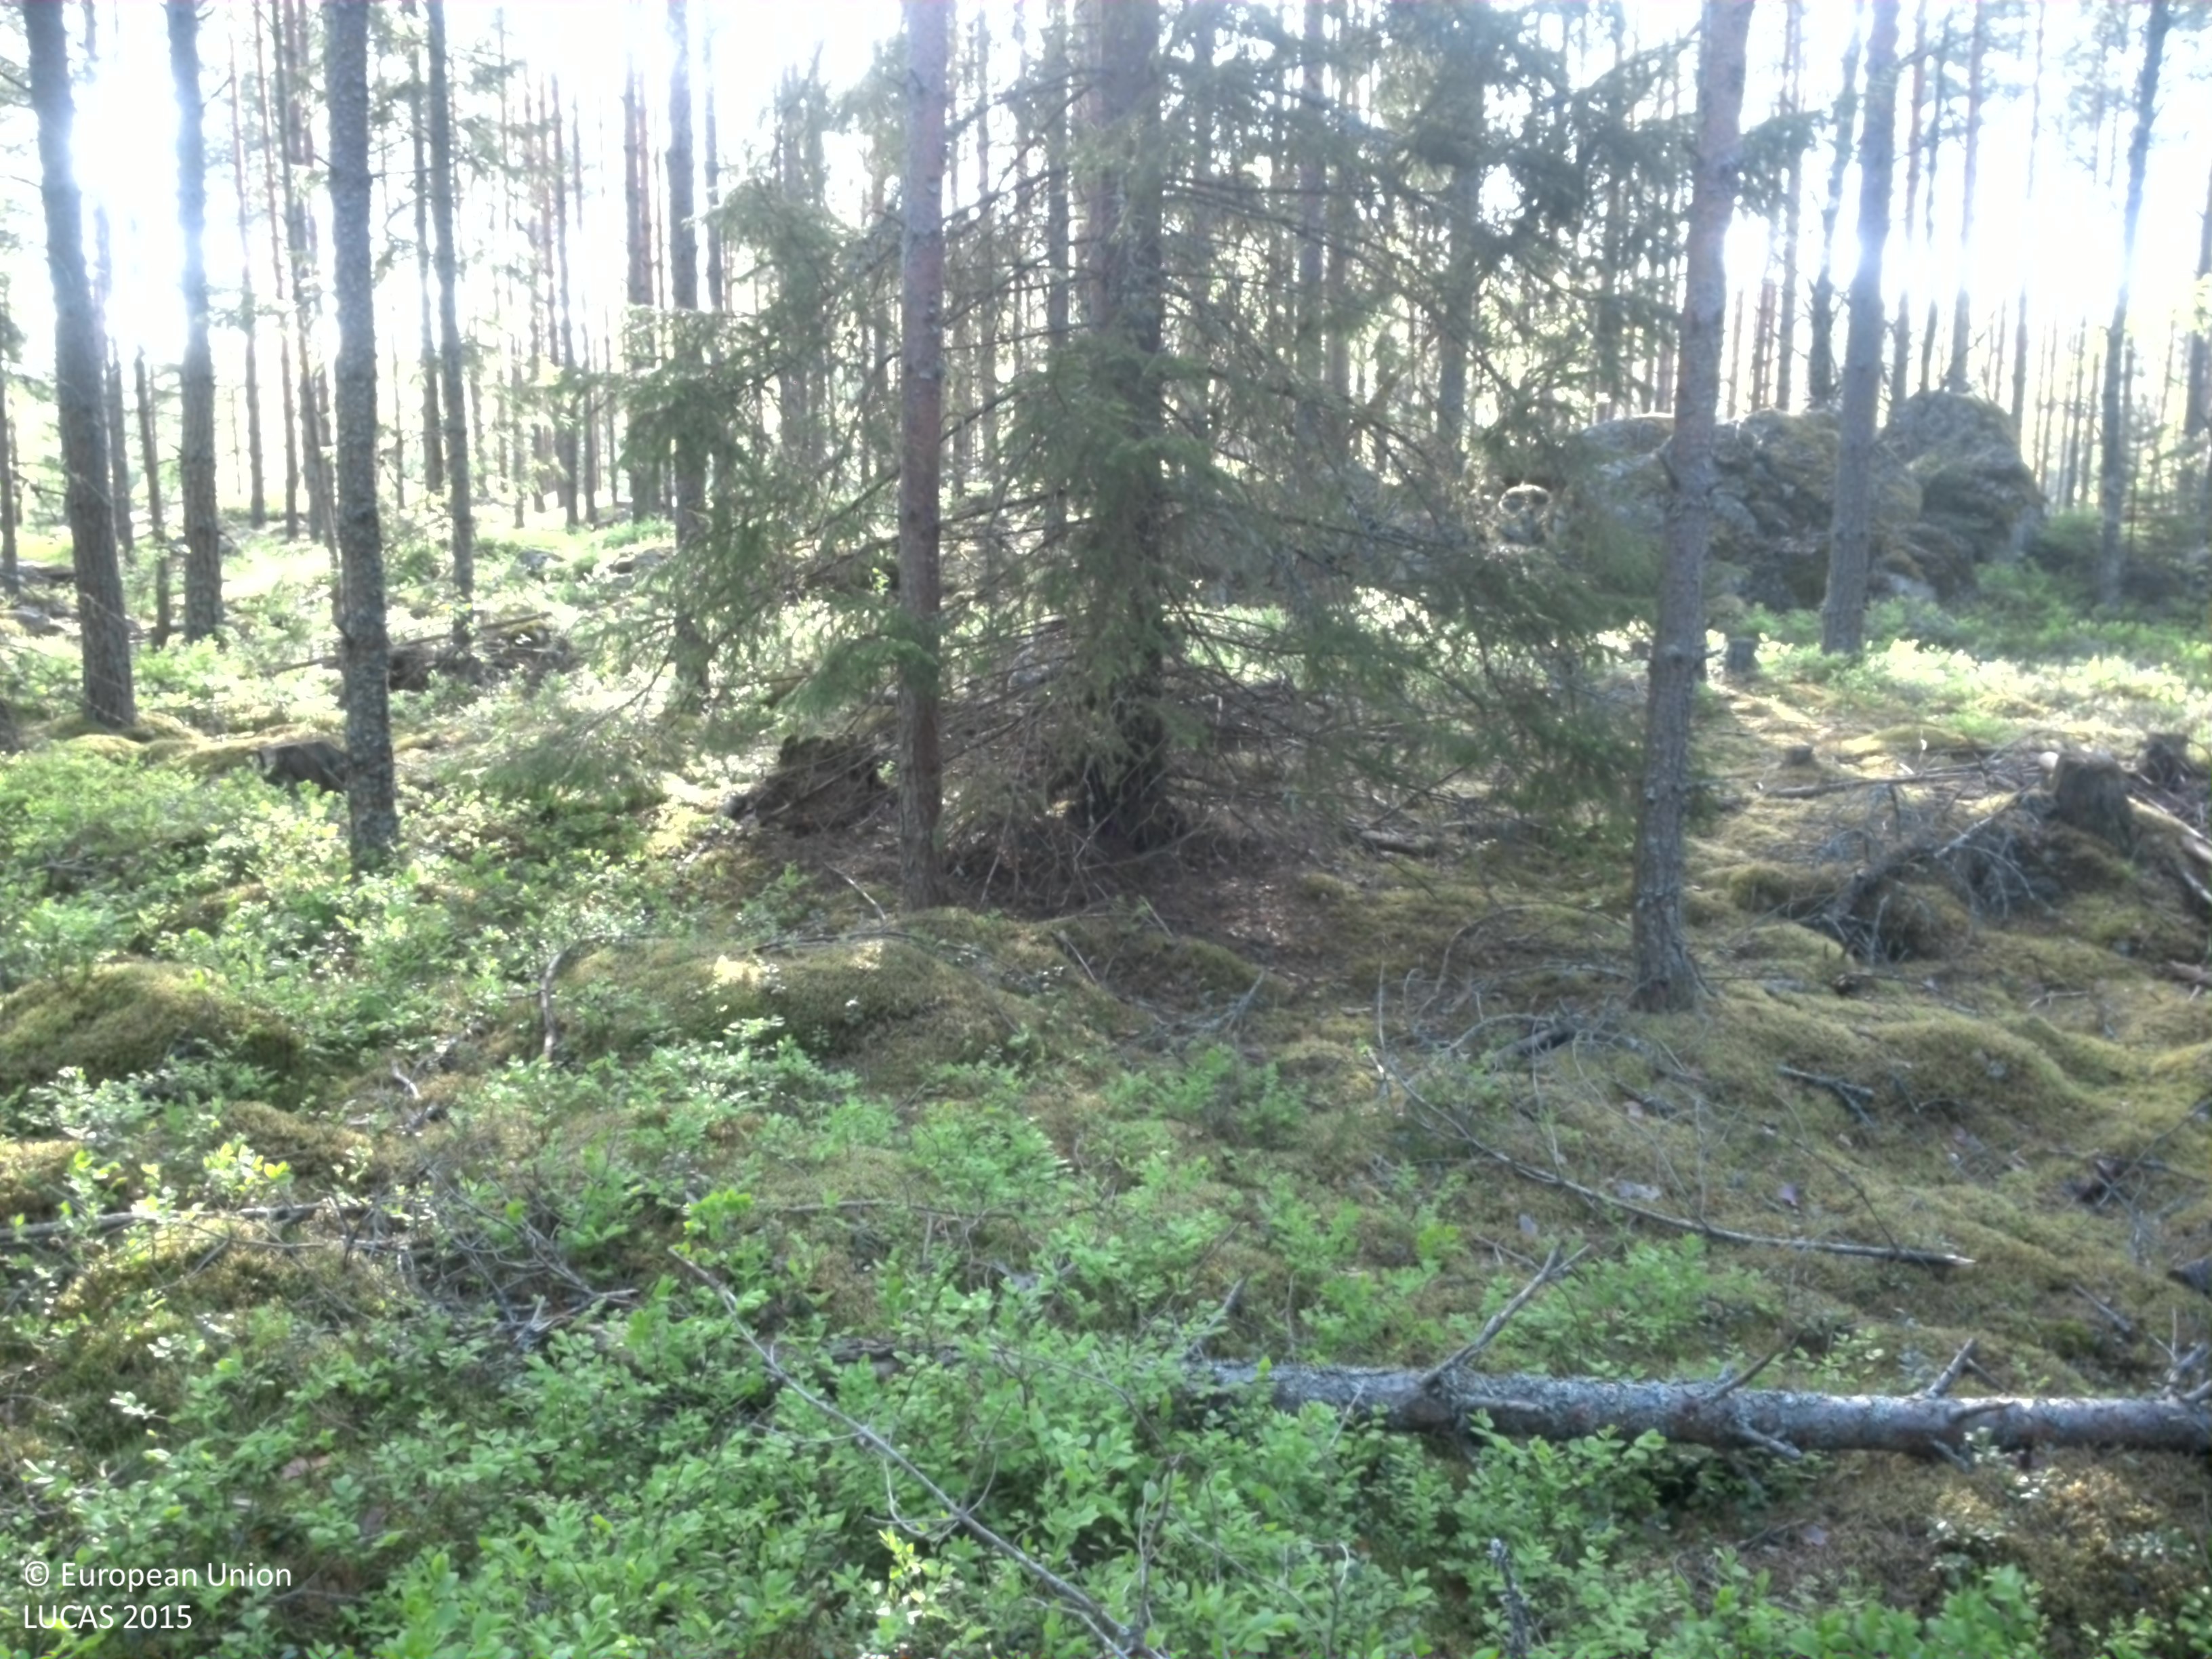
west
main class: Woodland
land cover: Pine dominated mixed woodland
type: boreal forest
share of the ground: 50 - 75 %
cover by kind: coniferous forest trees 40 %, broadleaved forest trees 25 %, shrubs 15 %, lichens and mosses 10 %, consolidated bare surface 10 %
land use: Forestry
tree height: > 5 m
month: June
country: SE
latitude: 59.2660
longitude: 14.3598
